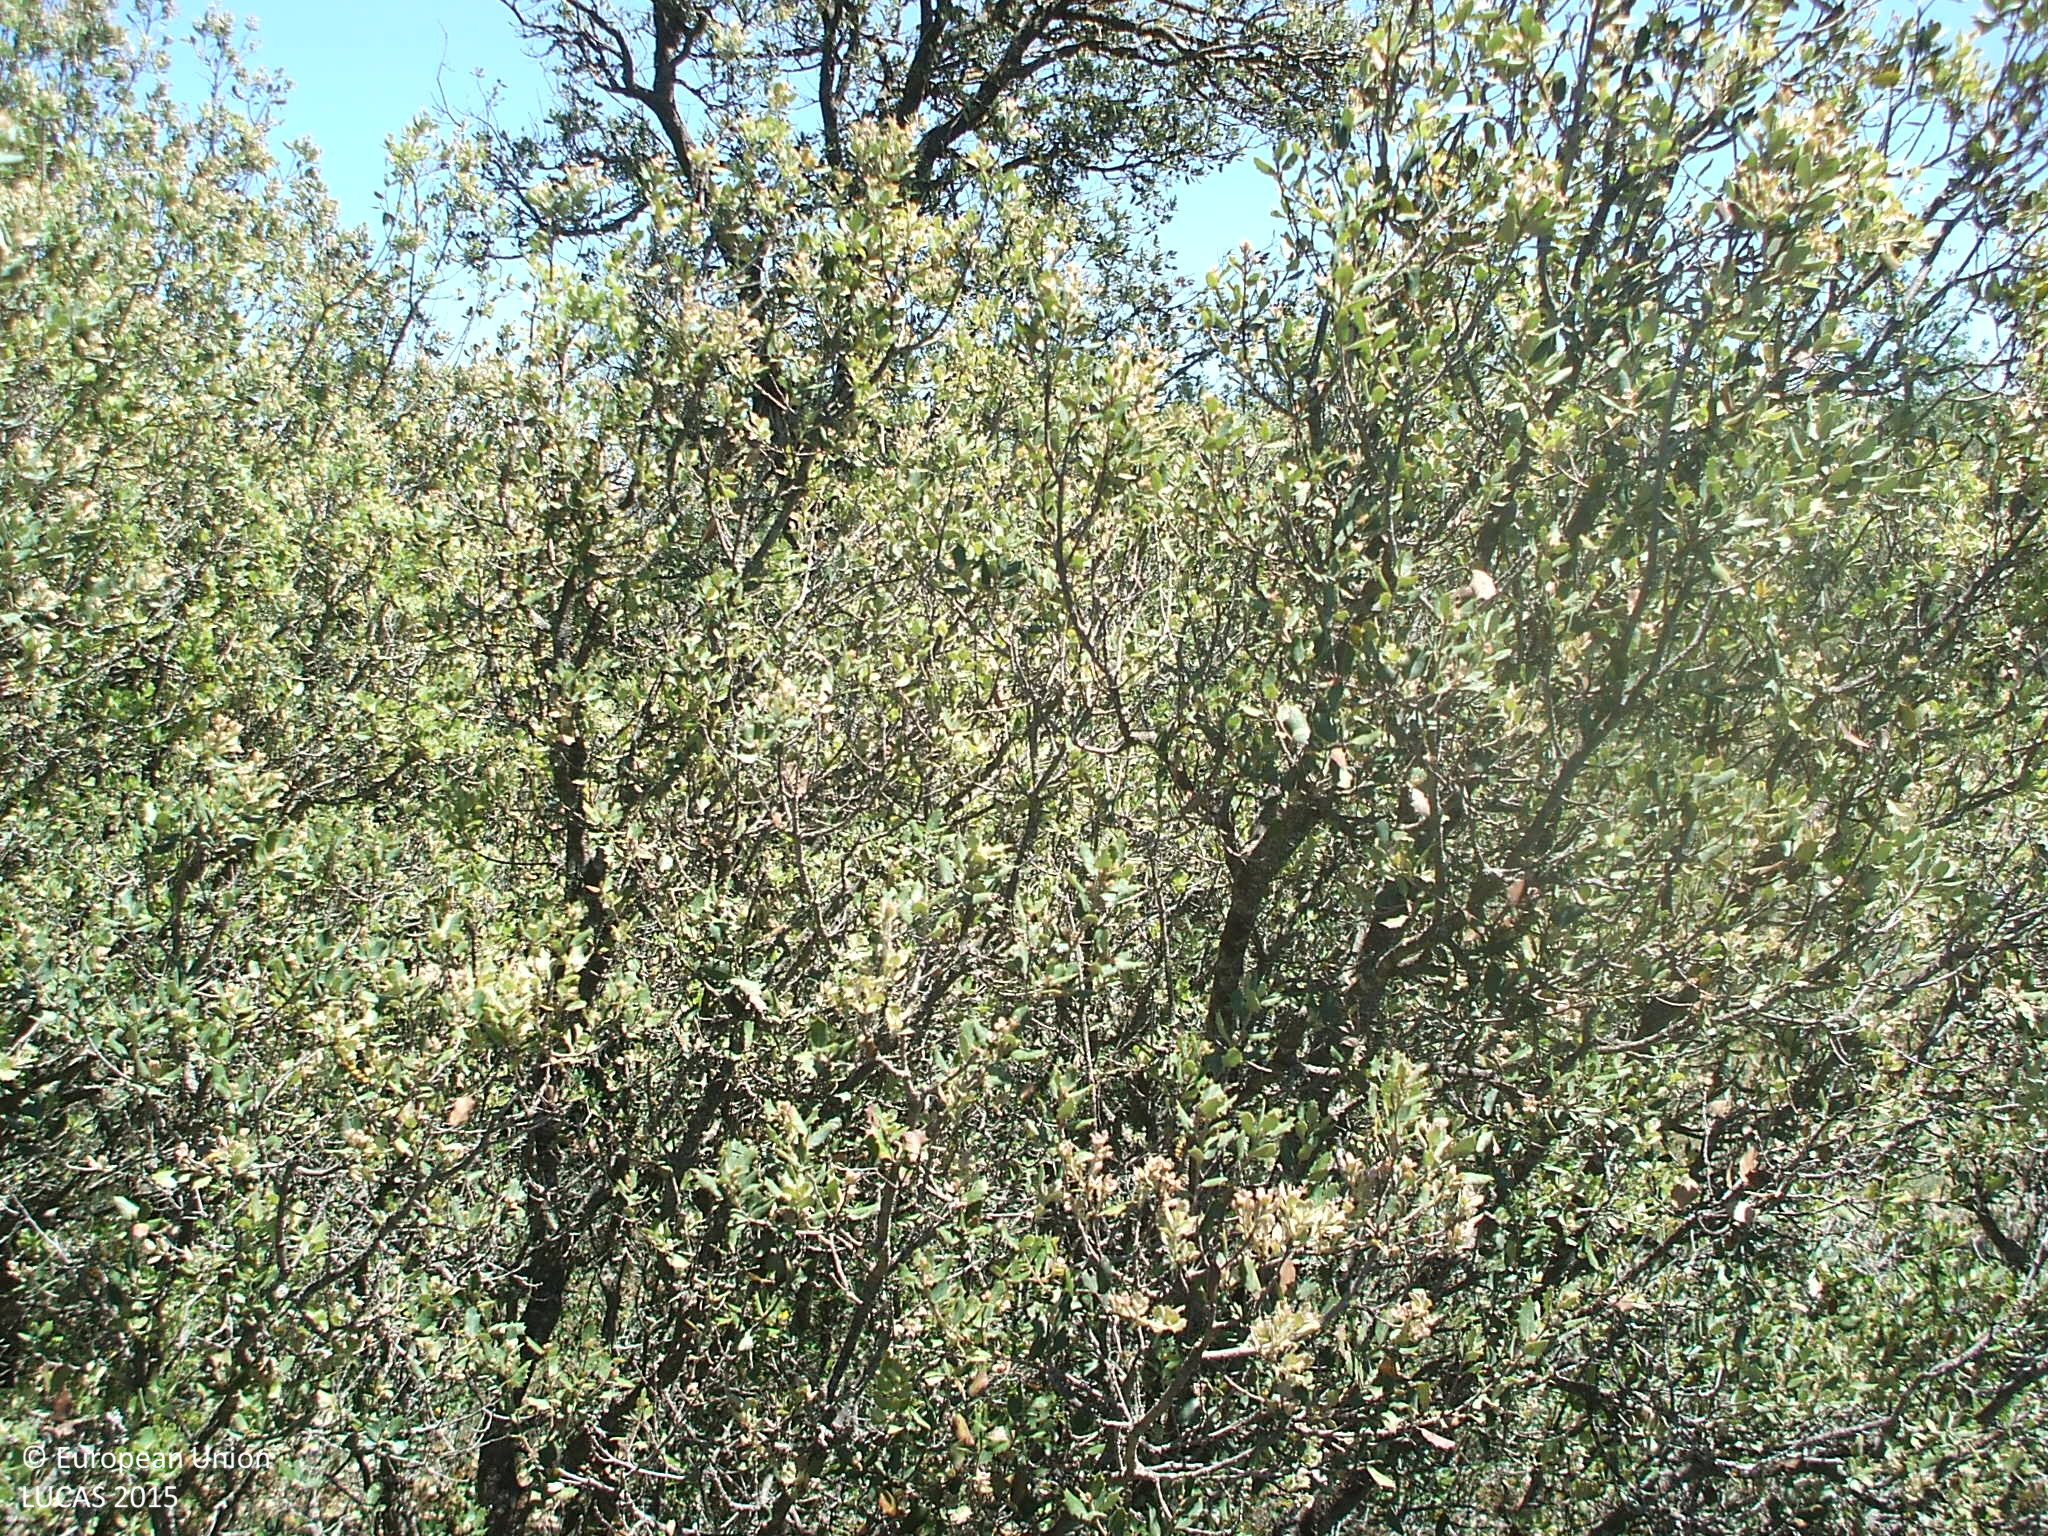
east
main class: Woodland
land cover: Broadleaved woodland
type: broadleaved evergreen forest
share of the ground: 50 - 75 %
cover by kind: broadleaved forest trees 70 %, shrubs 30 %
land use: Semi-natural and natural areas not in use
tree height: < 5 m
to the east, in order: Broadleaved woodland; Shrubland with sparse tree cover; Broadleaved woodland; Tracks; Shrubland with sparse tree cover; Broadleaved woodland; Dry stone walls; Shrubland with sparse tree cover; Broadleaved woodland; Dry stone walls; Broadleaved woodland
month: May
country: ES
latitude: 40.0061
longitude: -0.7233
